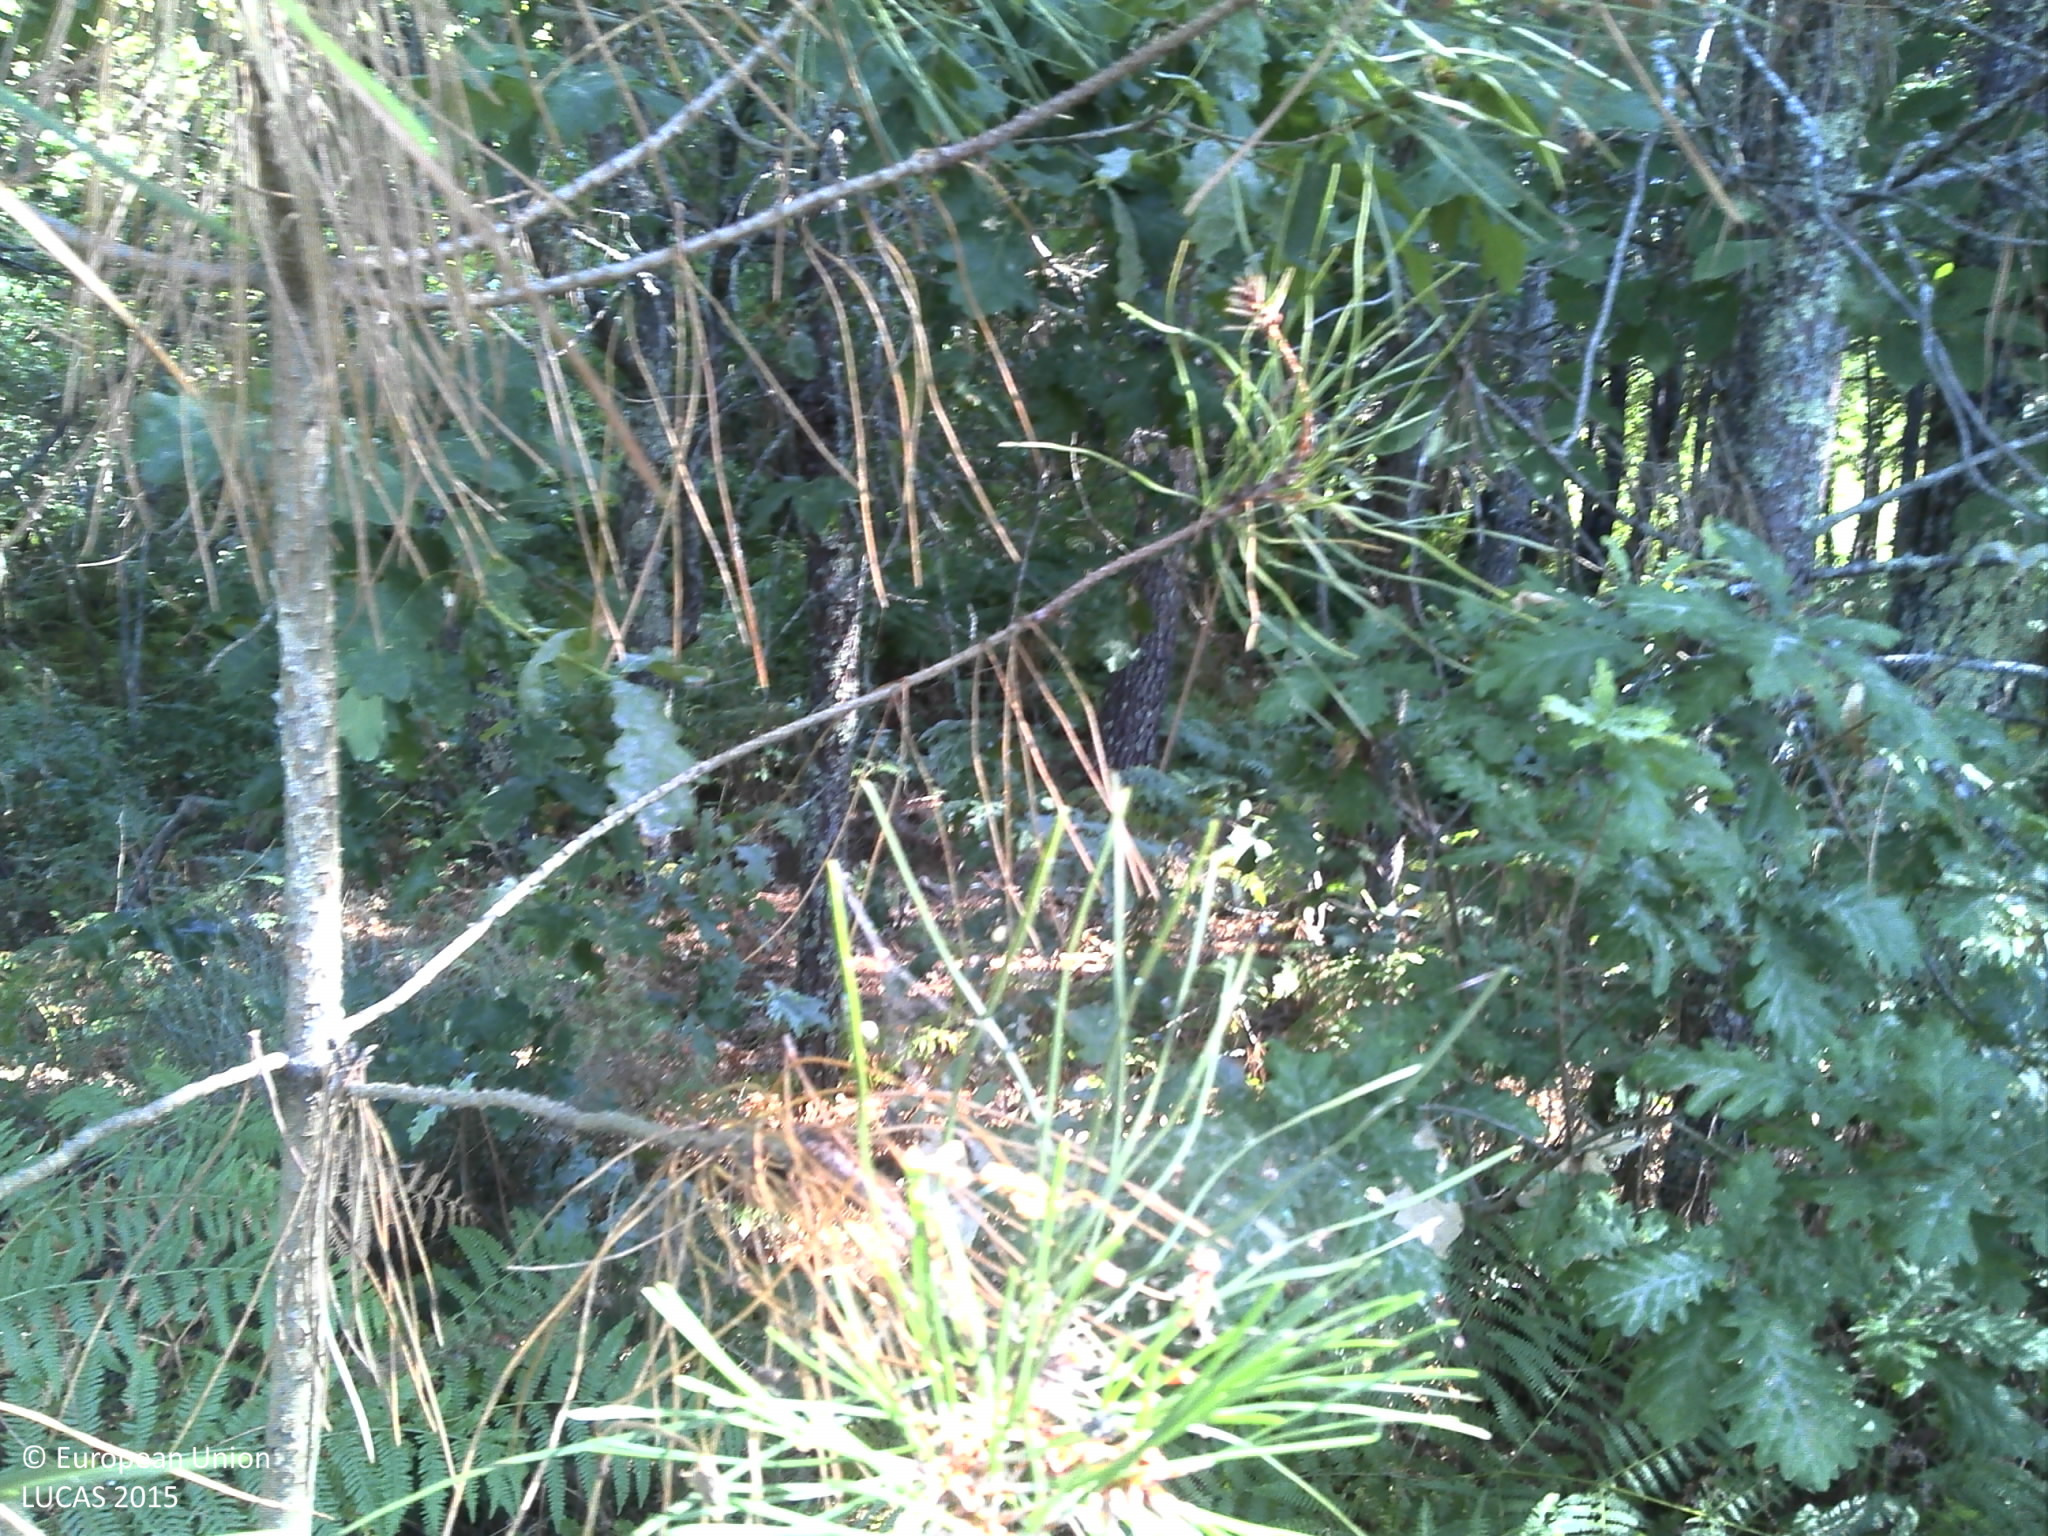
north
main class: Woodland
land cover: Pine dominated mixed woodland
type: coniferous forest of the mediterranean region
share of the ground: 10 - 25 %
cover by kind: shrubs 80 %, coniferous forest trees 15 %, broadleaved forest trees 5 %
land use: Forestry
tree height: > 5 m
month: July
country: PT
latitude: 40.8001
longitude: -7.8205
